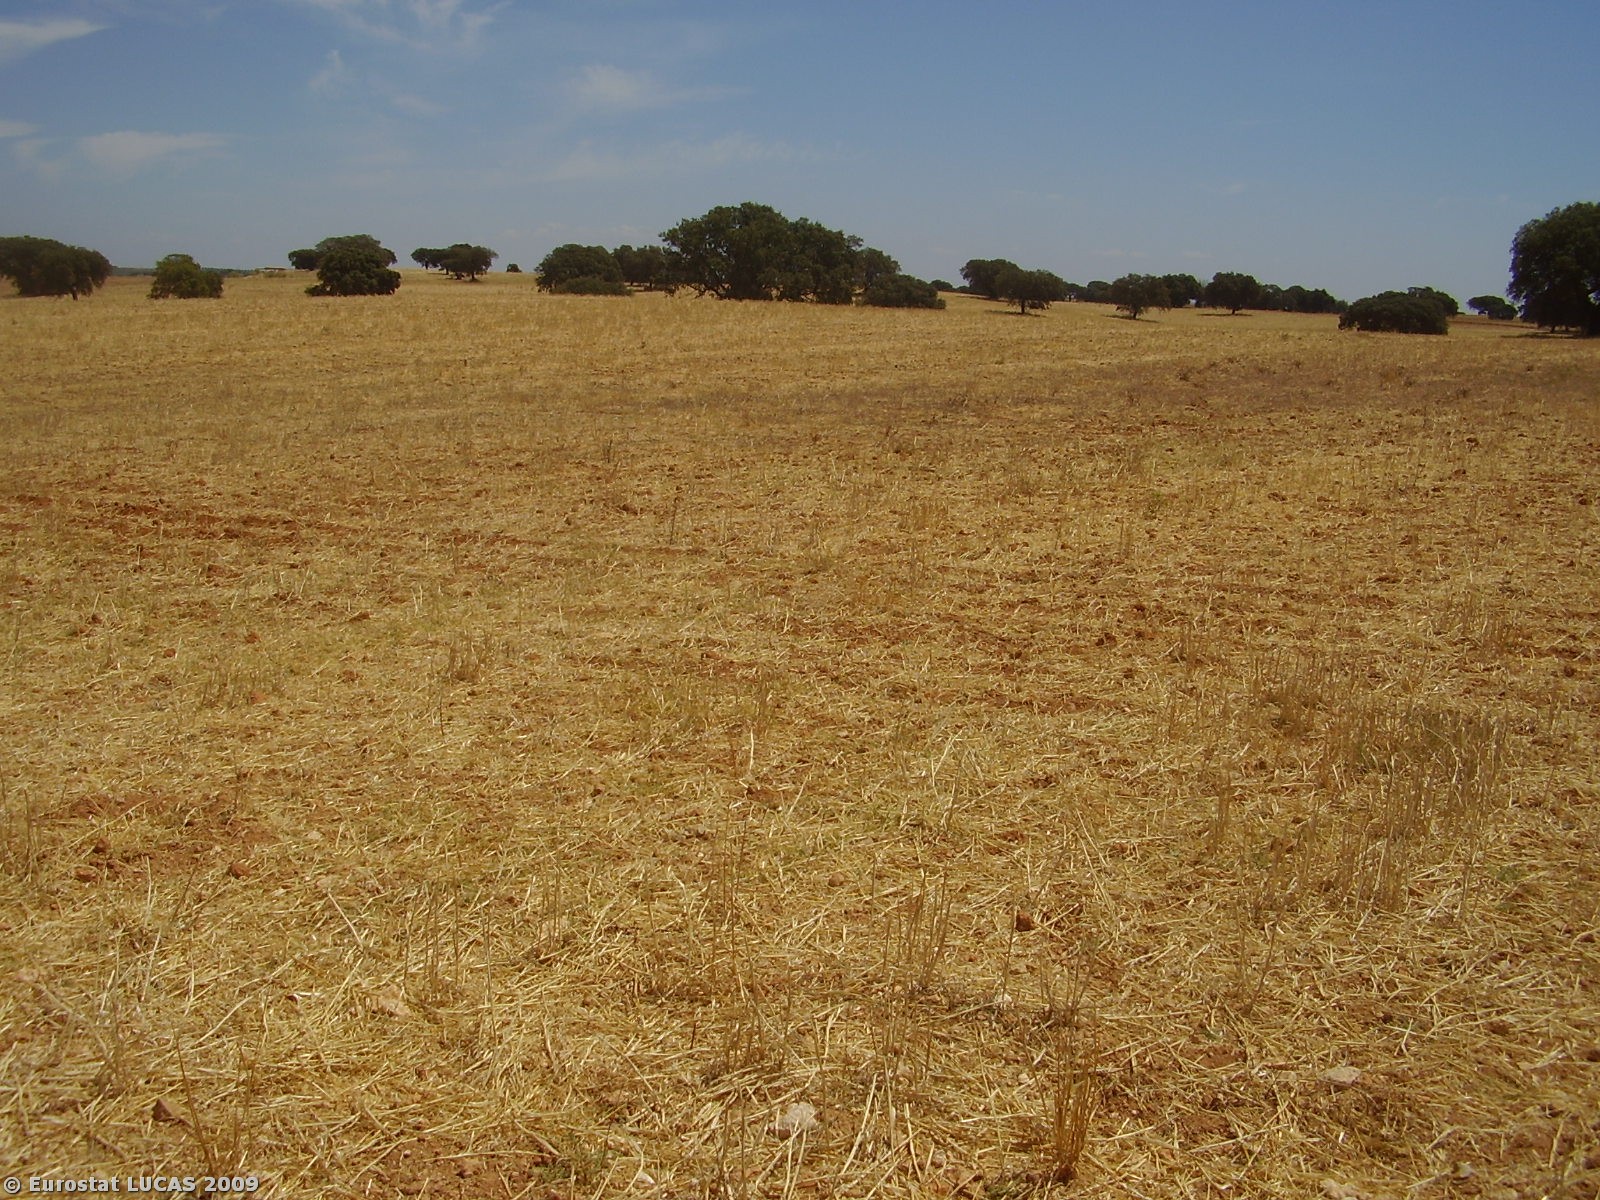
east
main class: Cropland
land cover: Oats
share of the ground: < 10 %
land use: Agriculture (excluding fallow land and kitchen gardens)
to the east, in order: Oats
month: August
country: PT
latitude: 38.0947
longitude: -7.5712
